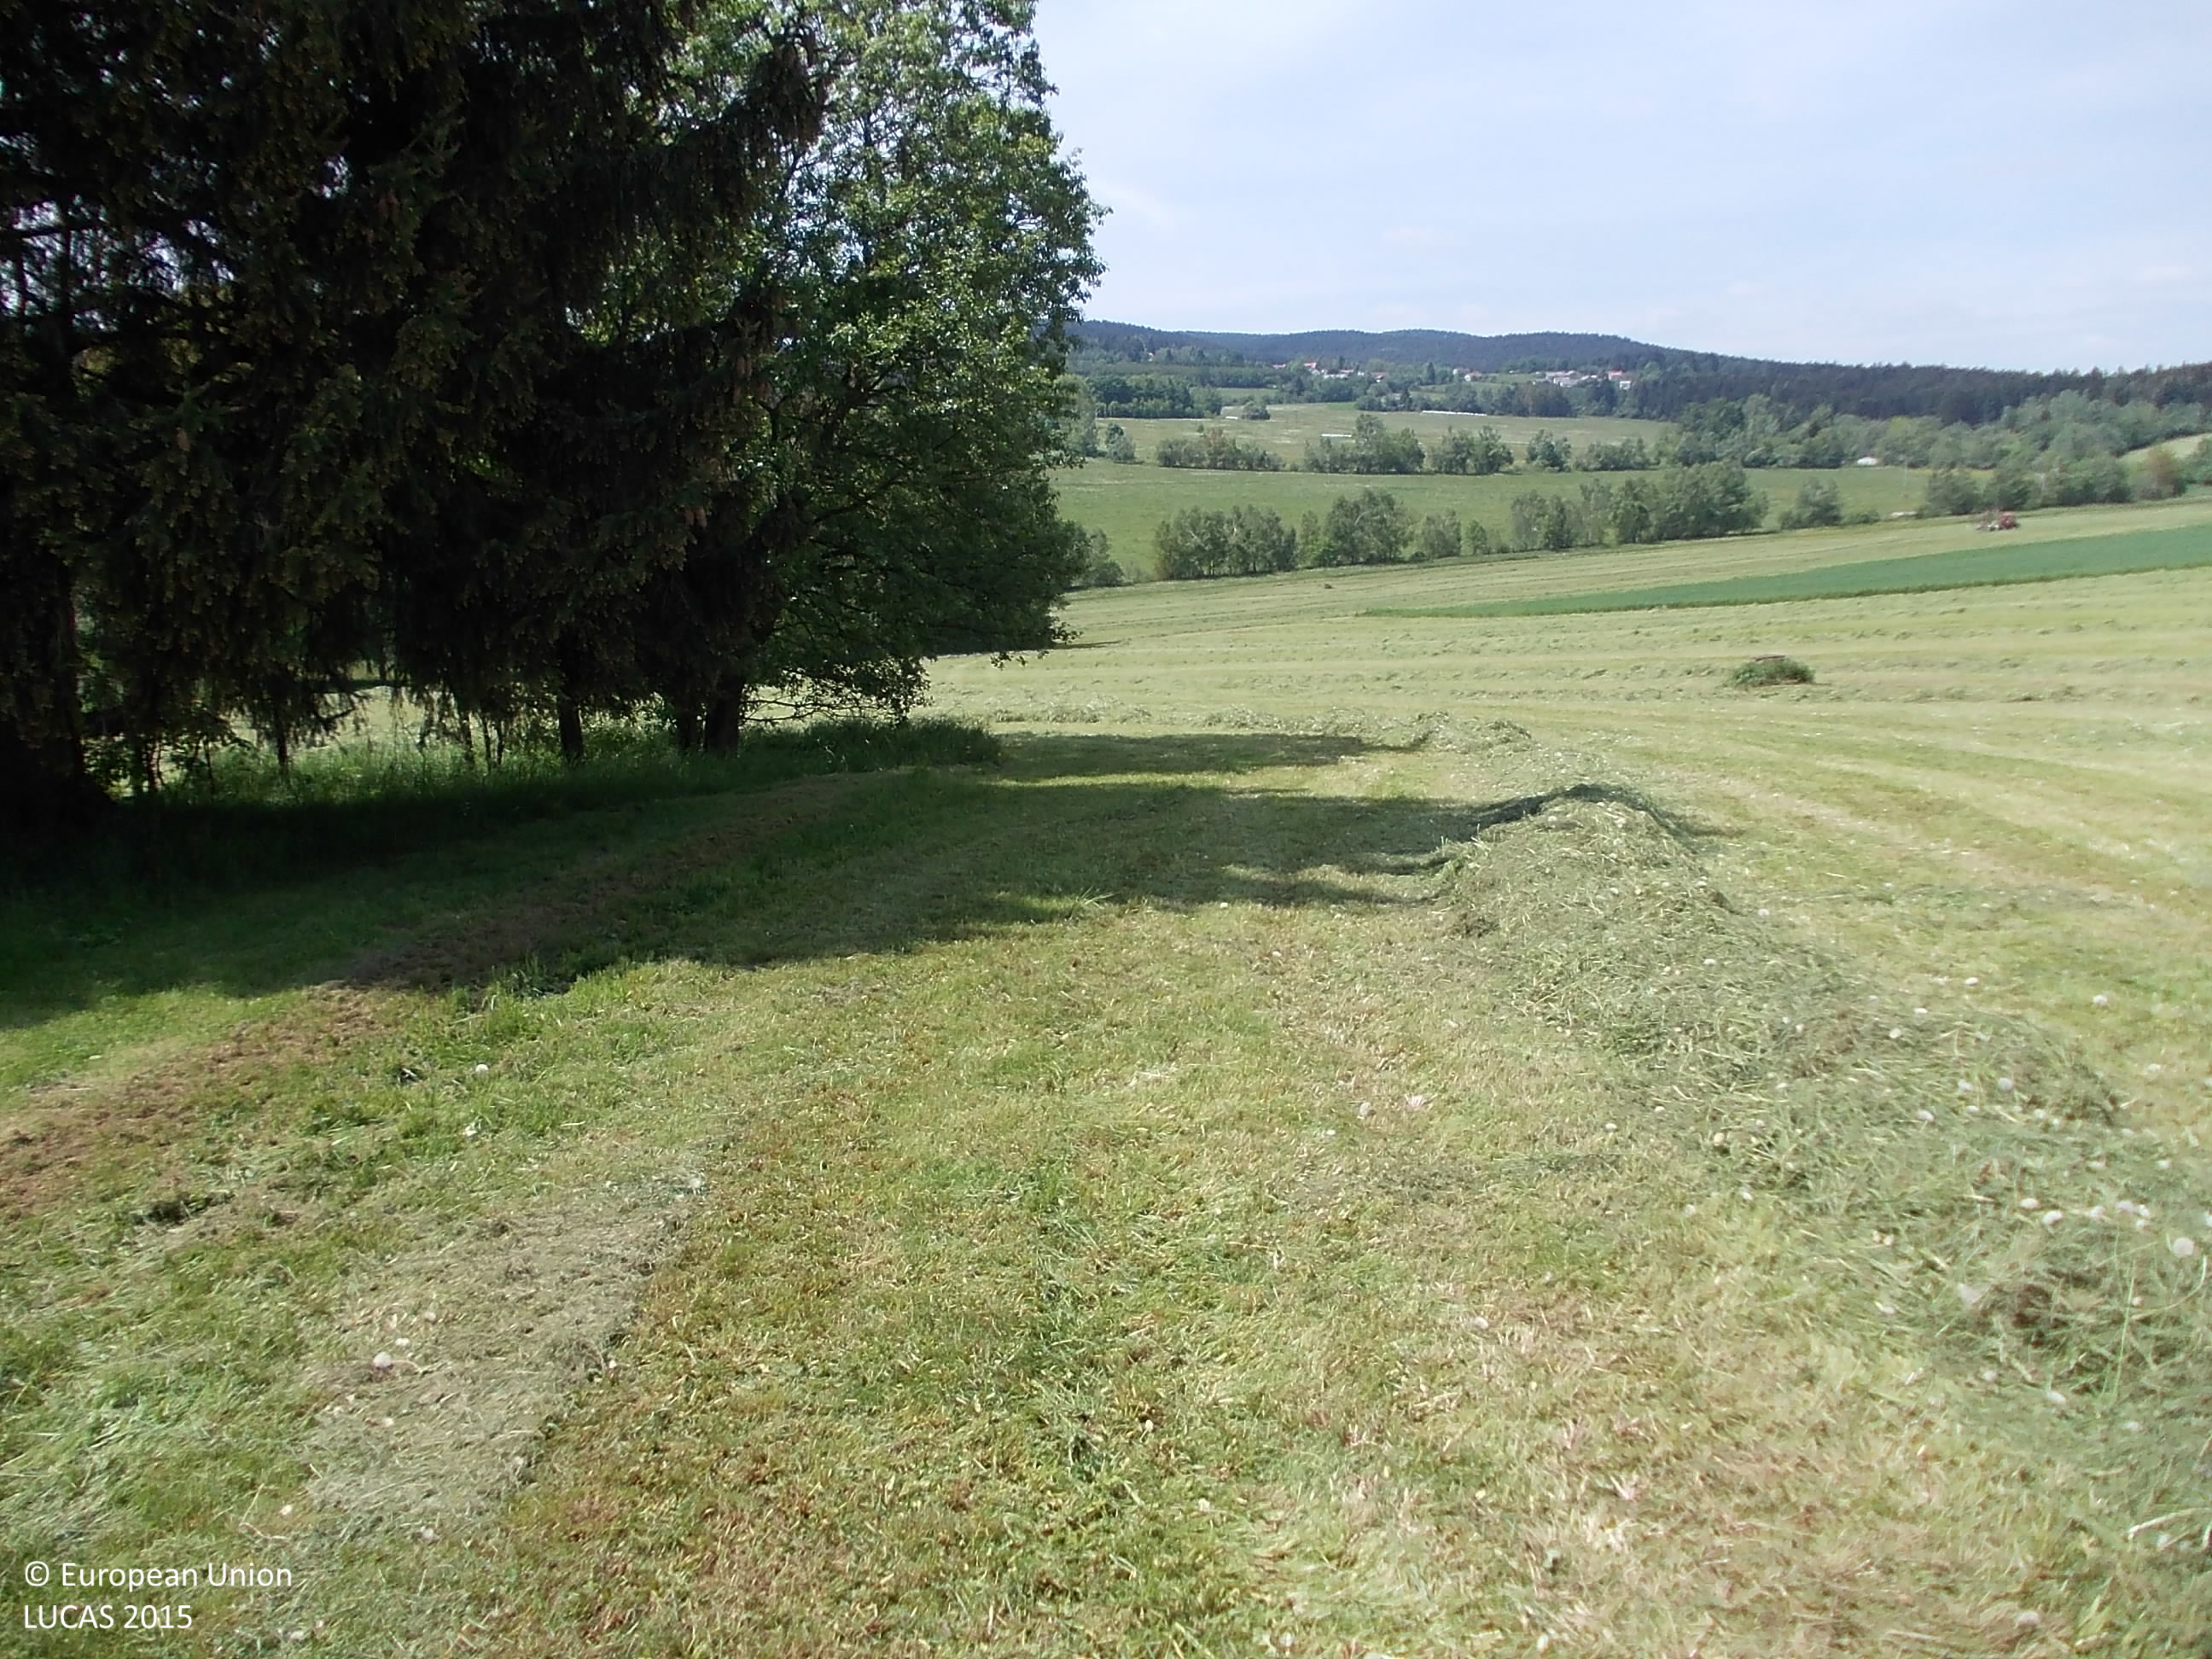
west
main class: Grassland
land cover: Grassland without tree/shrub cover
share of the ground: > 75 %
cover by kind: herbaceous plants 100 %
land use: Agriculture (excluding fallow land and kitchen gardens)
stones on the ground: < 10 %
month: May
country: CZ
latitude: 49.1335
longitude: 13.7144
